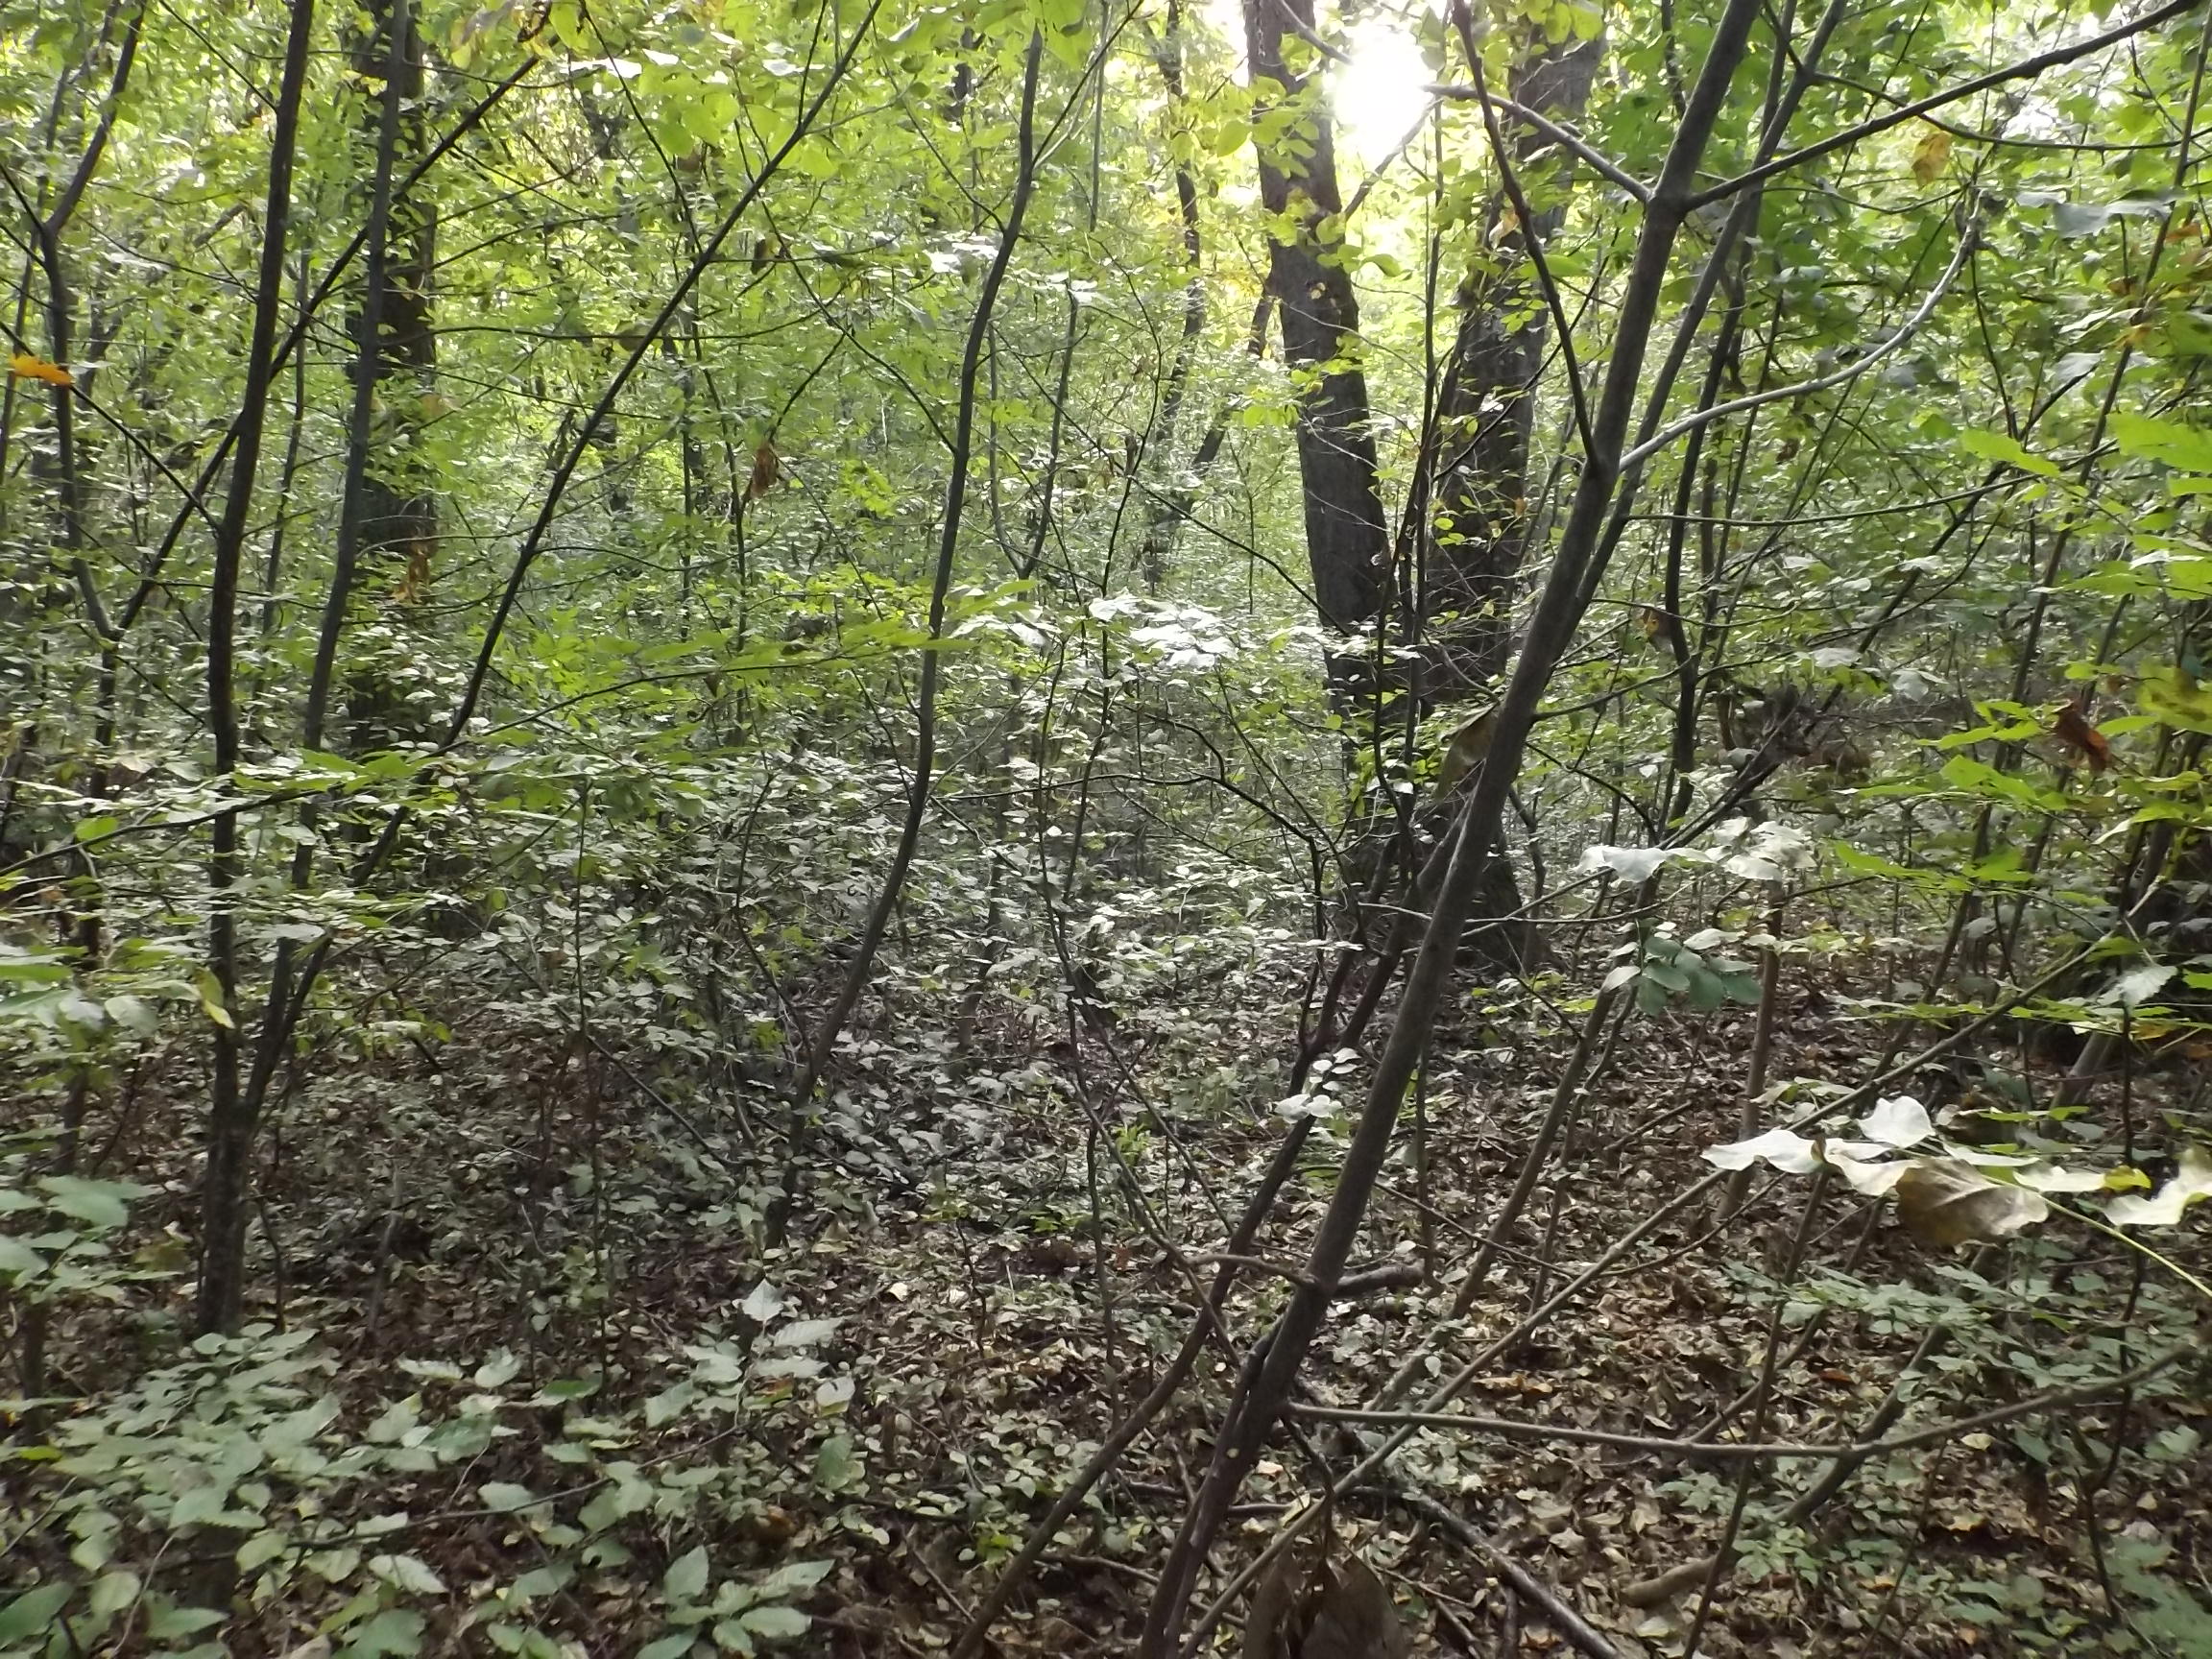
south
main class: Woodland
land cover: Broadleaved woodland
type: beech forest
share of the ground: > 75 %
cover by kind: broadleaved forest trees 100 %
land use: Forestry
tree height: > 5 m
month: October
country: BG
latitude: 43.8655
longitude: 26.8279
